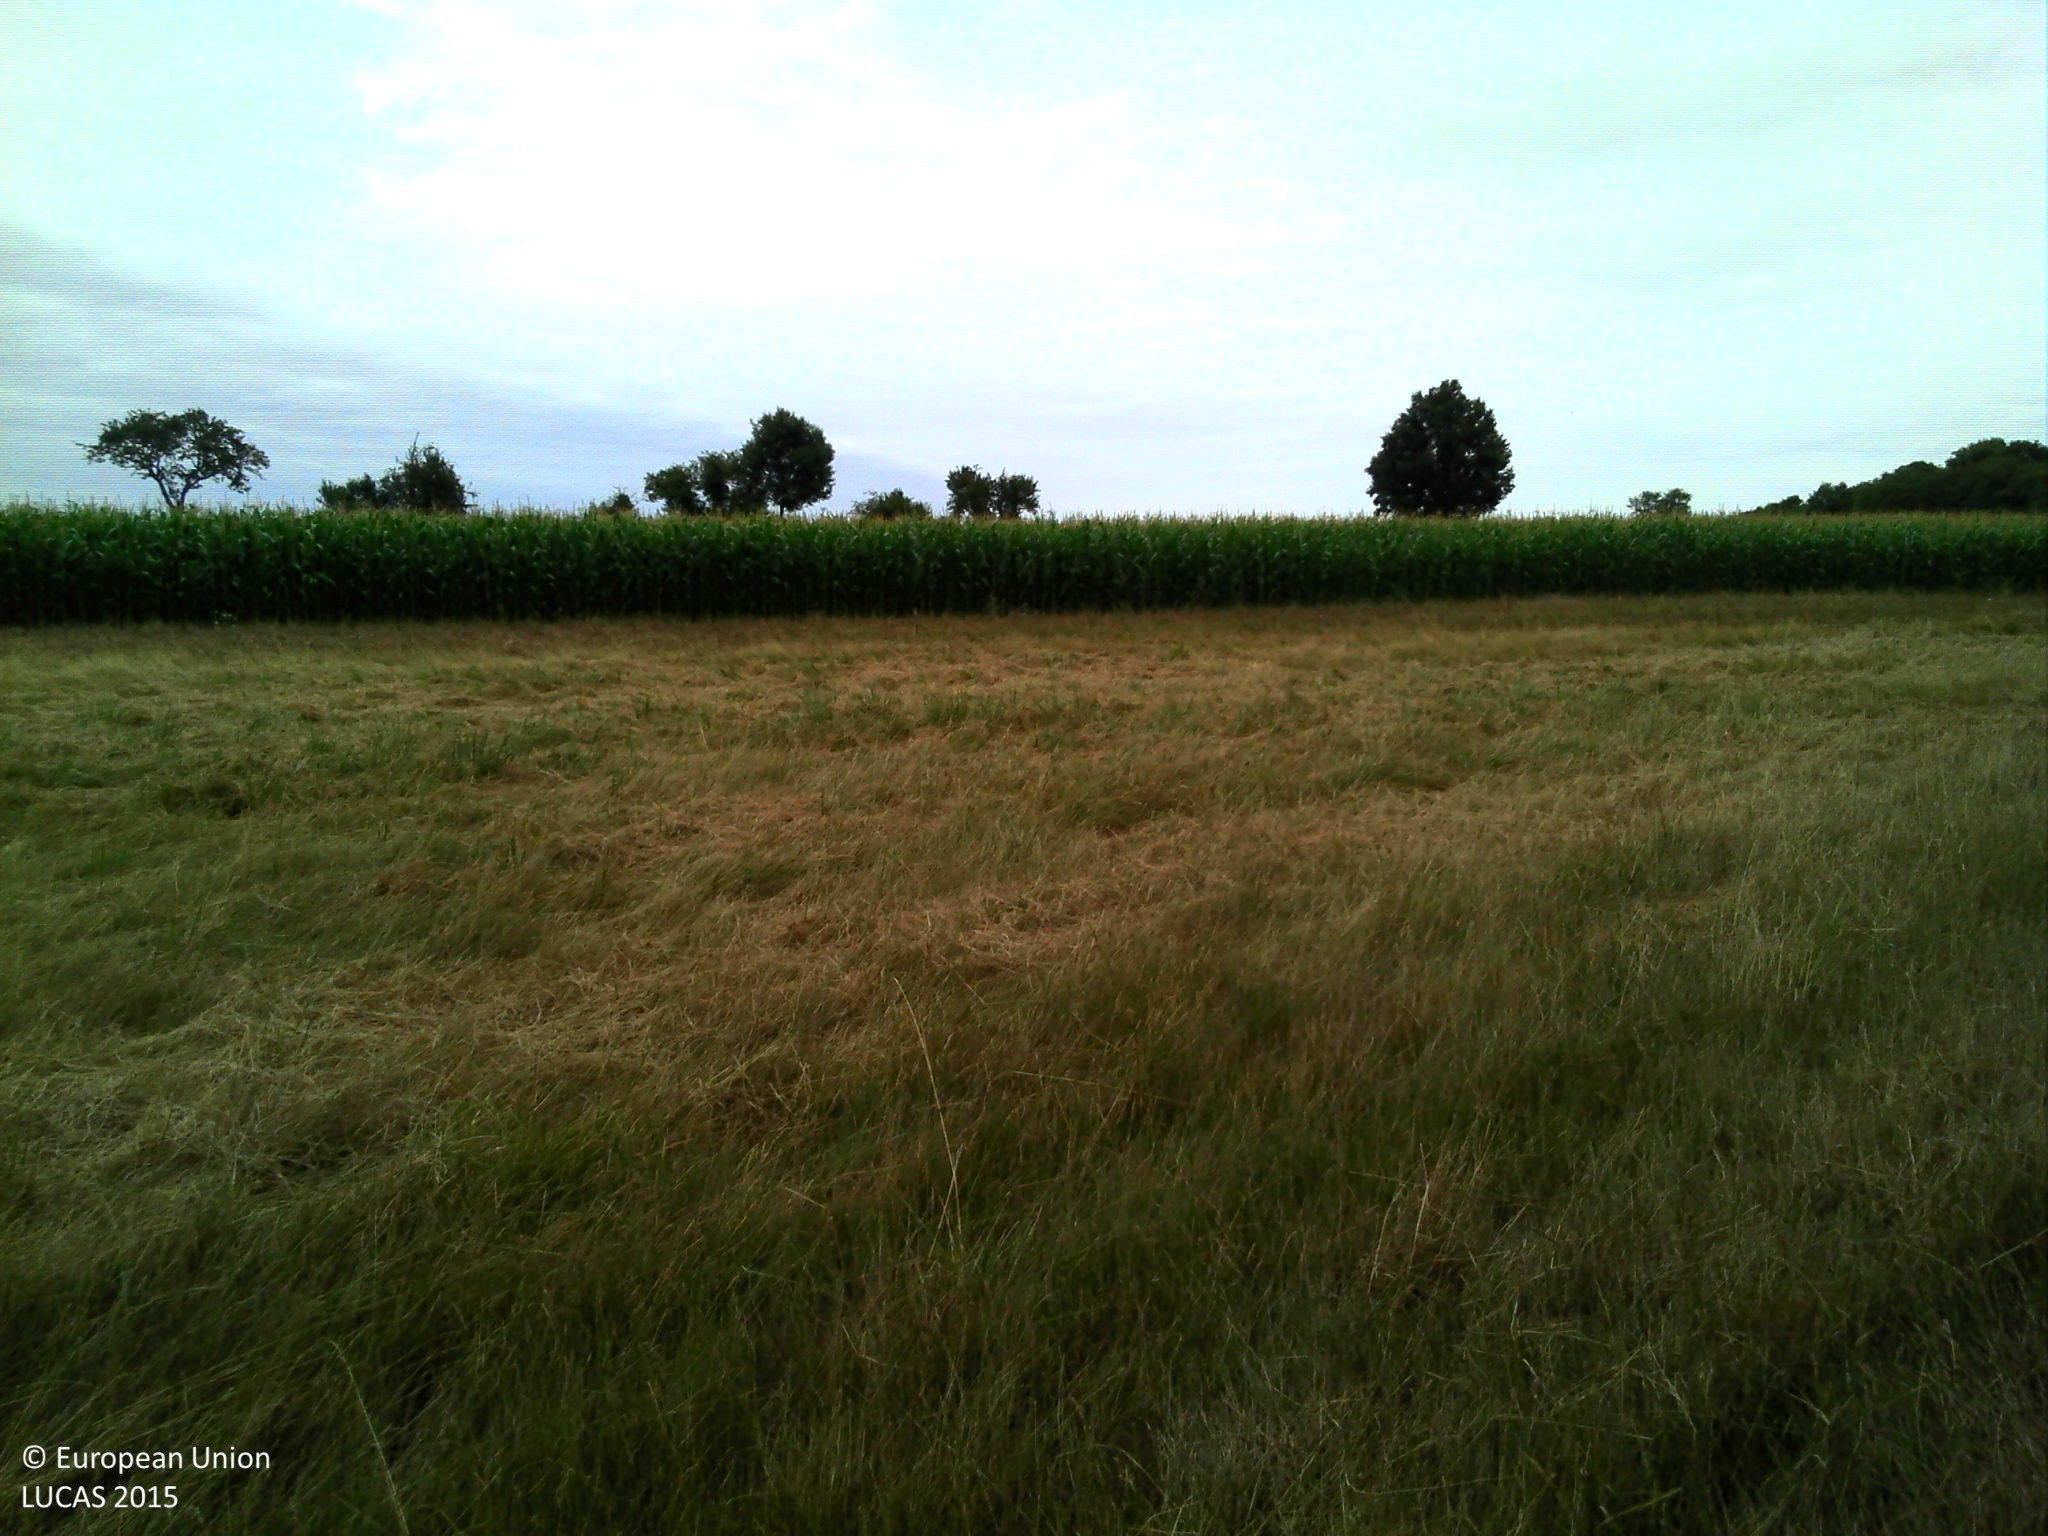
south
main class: Grassland
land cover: Grassland without tree/shrub cover
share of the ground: > 75 %
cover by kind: herbaceous plants 100 %
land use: Agriculture (excluding fallow land and kitchen gardens)
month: July
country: FR
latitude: 46.3322
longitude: 0.5658
